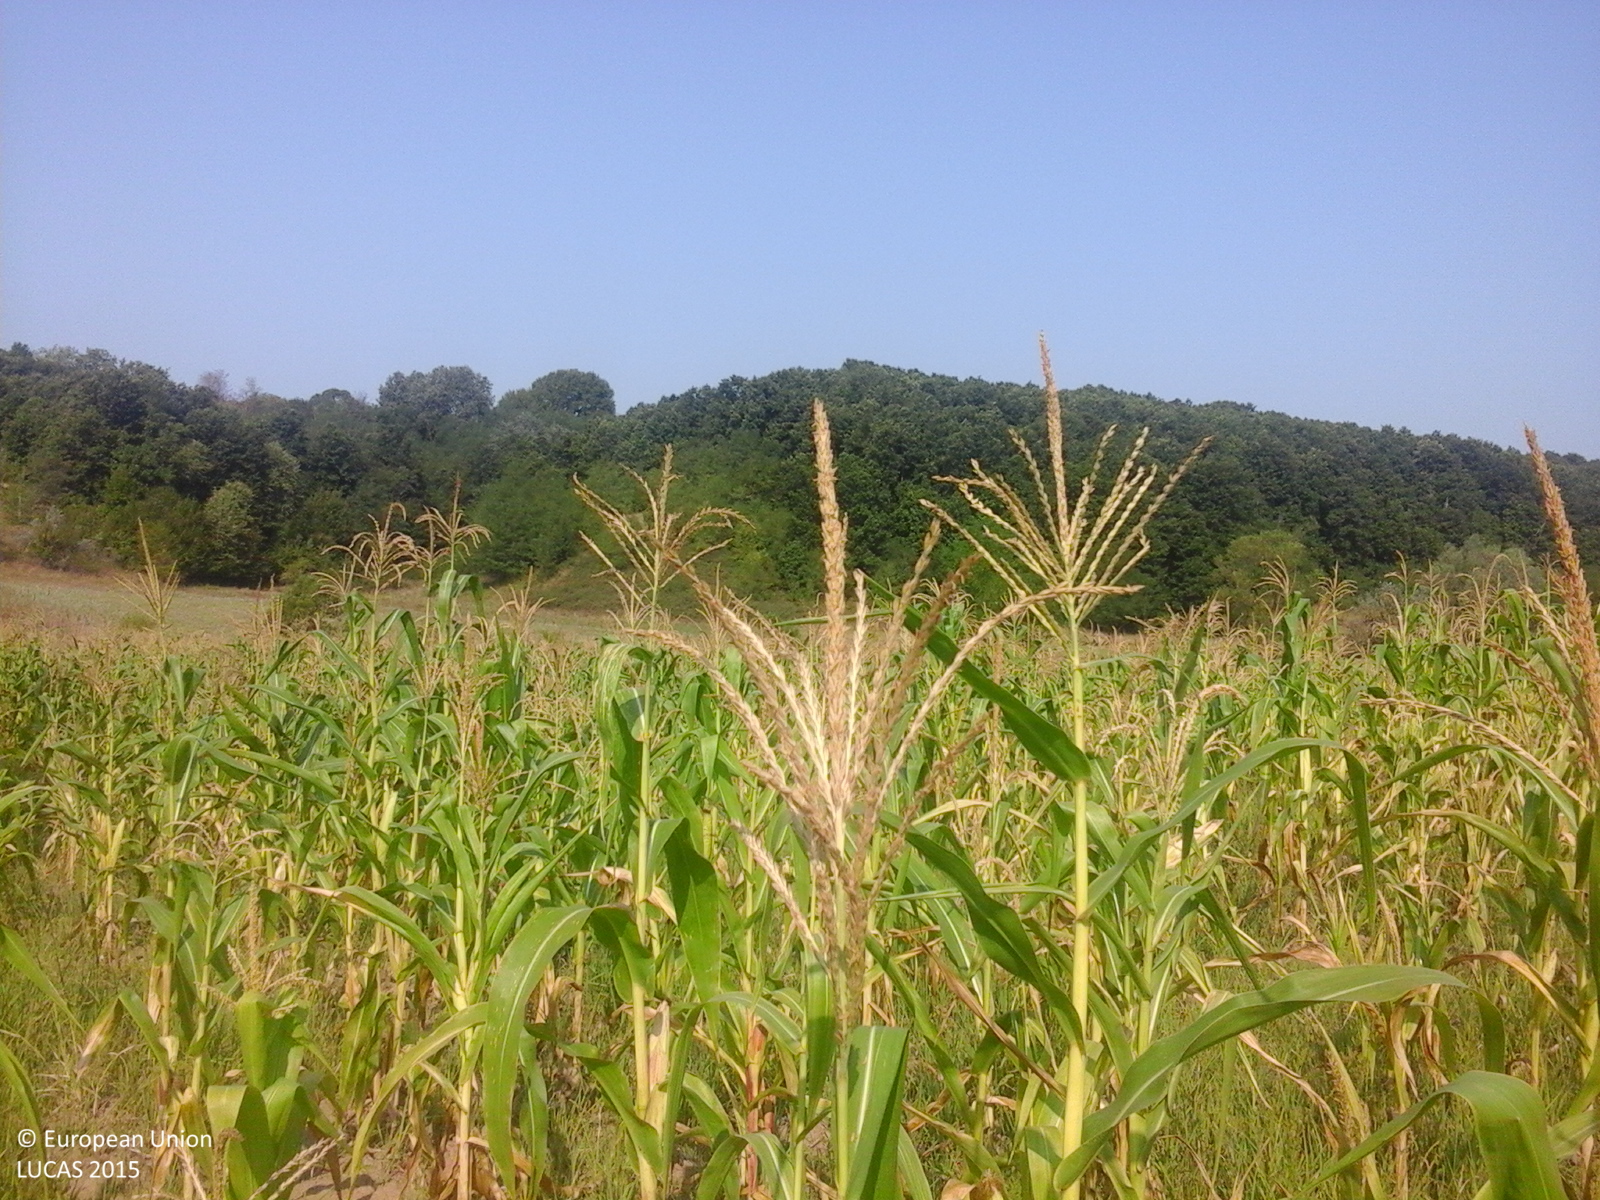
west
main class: Cropland
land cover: Maize
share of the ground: > 75 %
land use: Agriculture (excluding fallow land and kitchen gardens)
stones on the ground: < 10 %
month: August
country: RO
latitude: 44.6214
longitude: 23.8609
